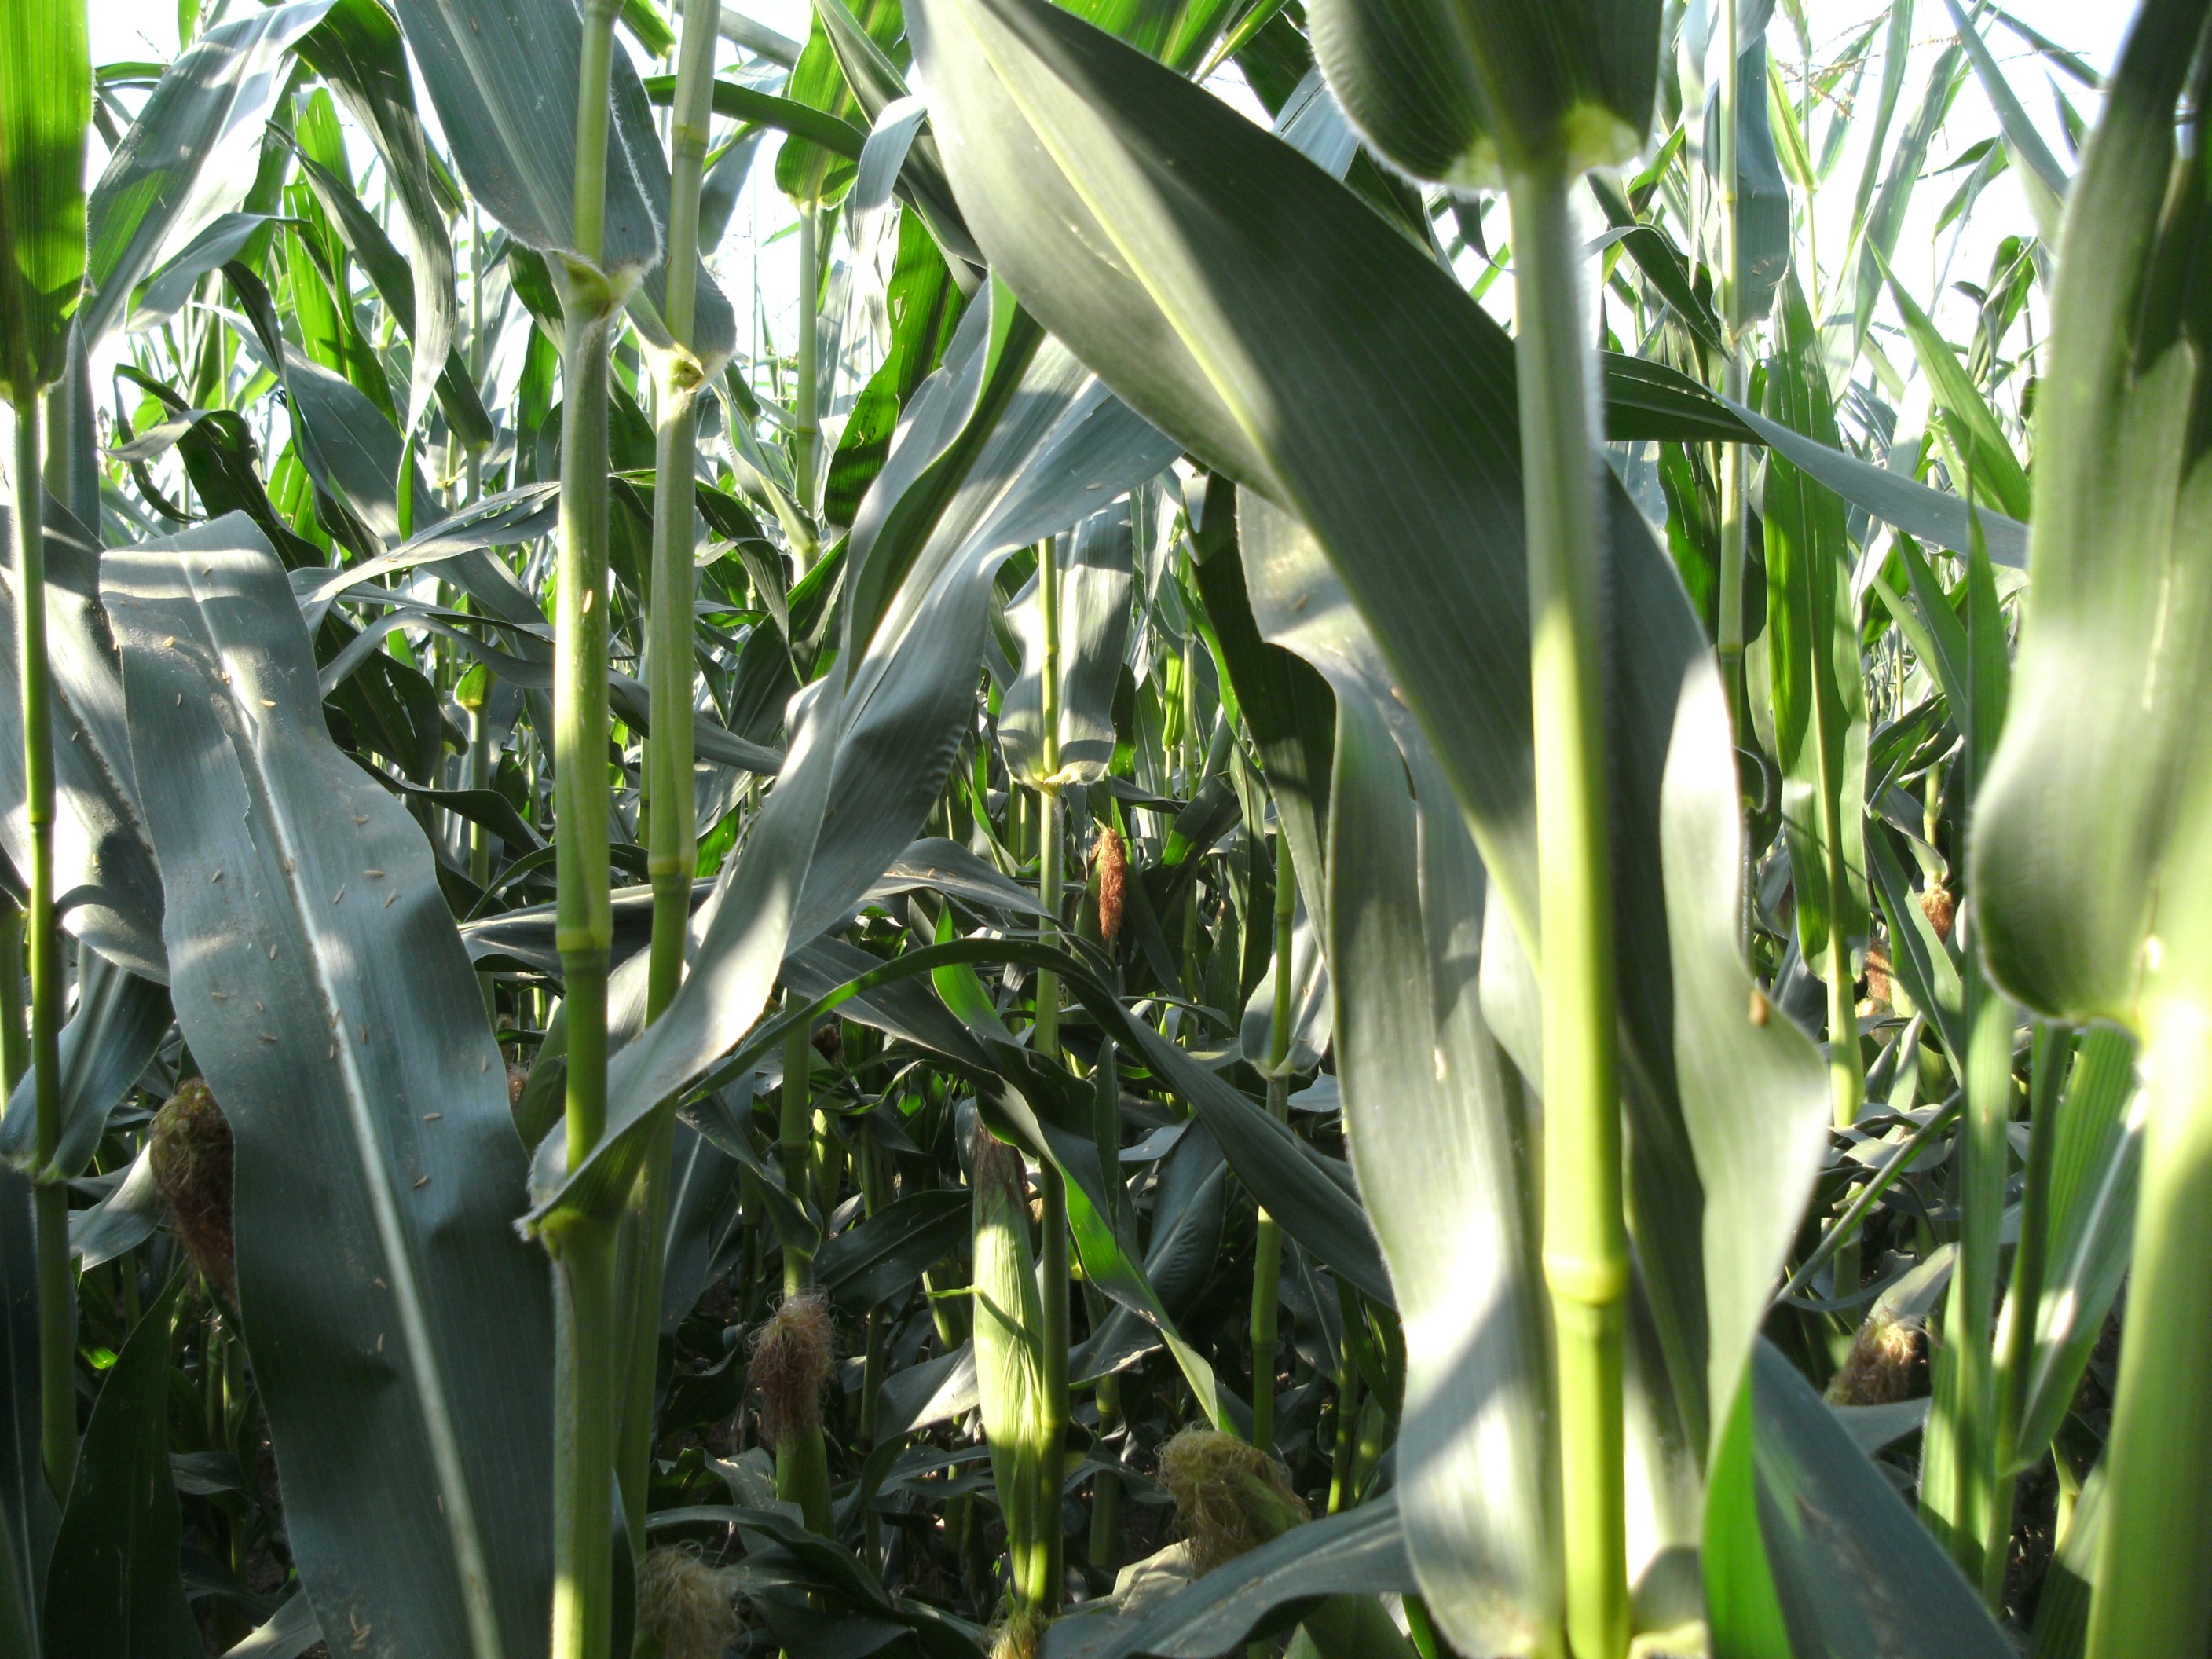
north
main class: Cropland
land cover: Maize
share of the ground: > 75 %
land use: Agriculture (excluding fallow land and kitchen gardens)
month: July
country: AT
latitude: 46.5497
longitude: 14.8103
